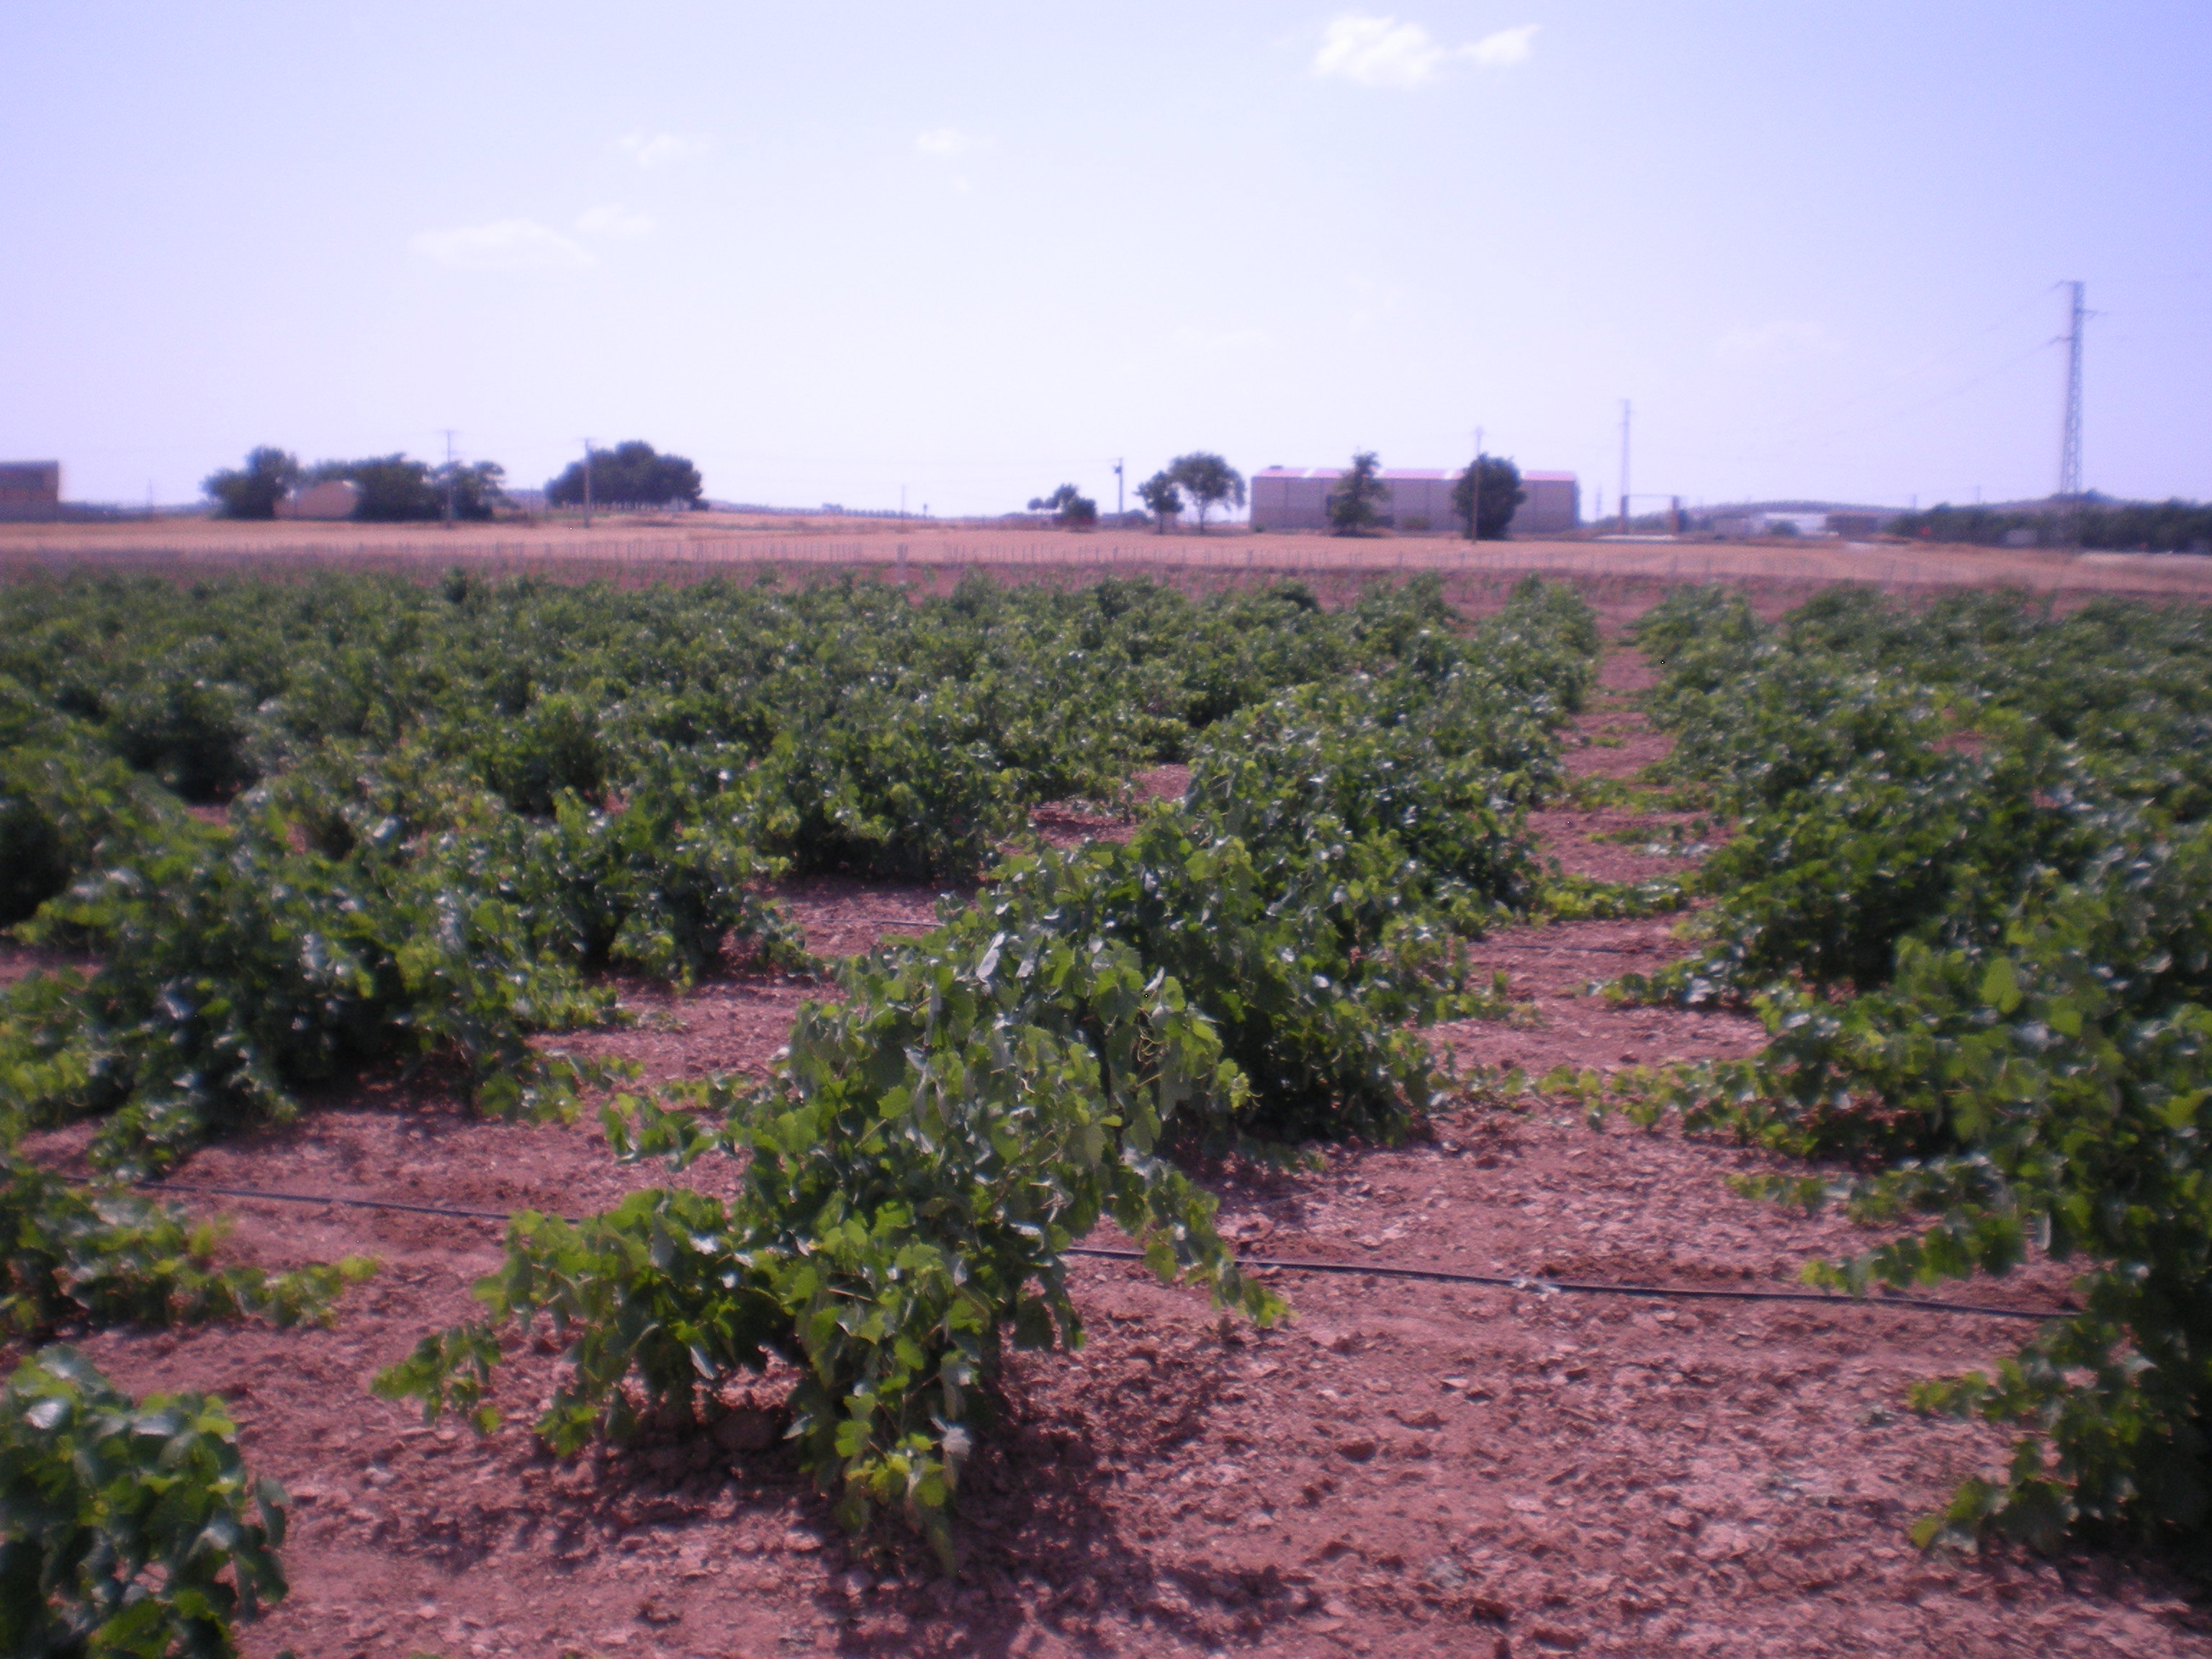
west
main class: Cropland
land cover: Vineyards
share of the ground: 25 - 50 %
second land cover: Other bare soil
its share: > 75 %
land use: Agriculture (excluding fallow land and kitchen gardens)
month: June
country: ES
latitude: 39.6090
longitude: -3.3349
